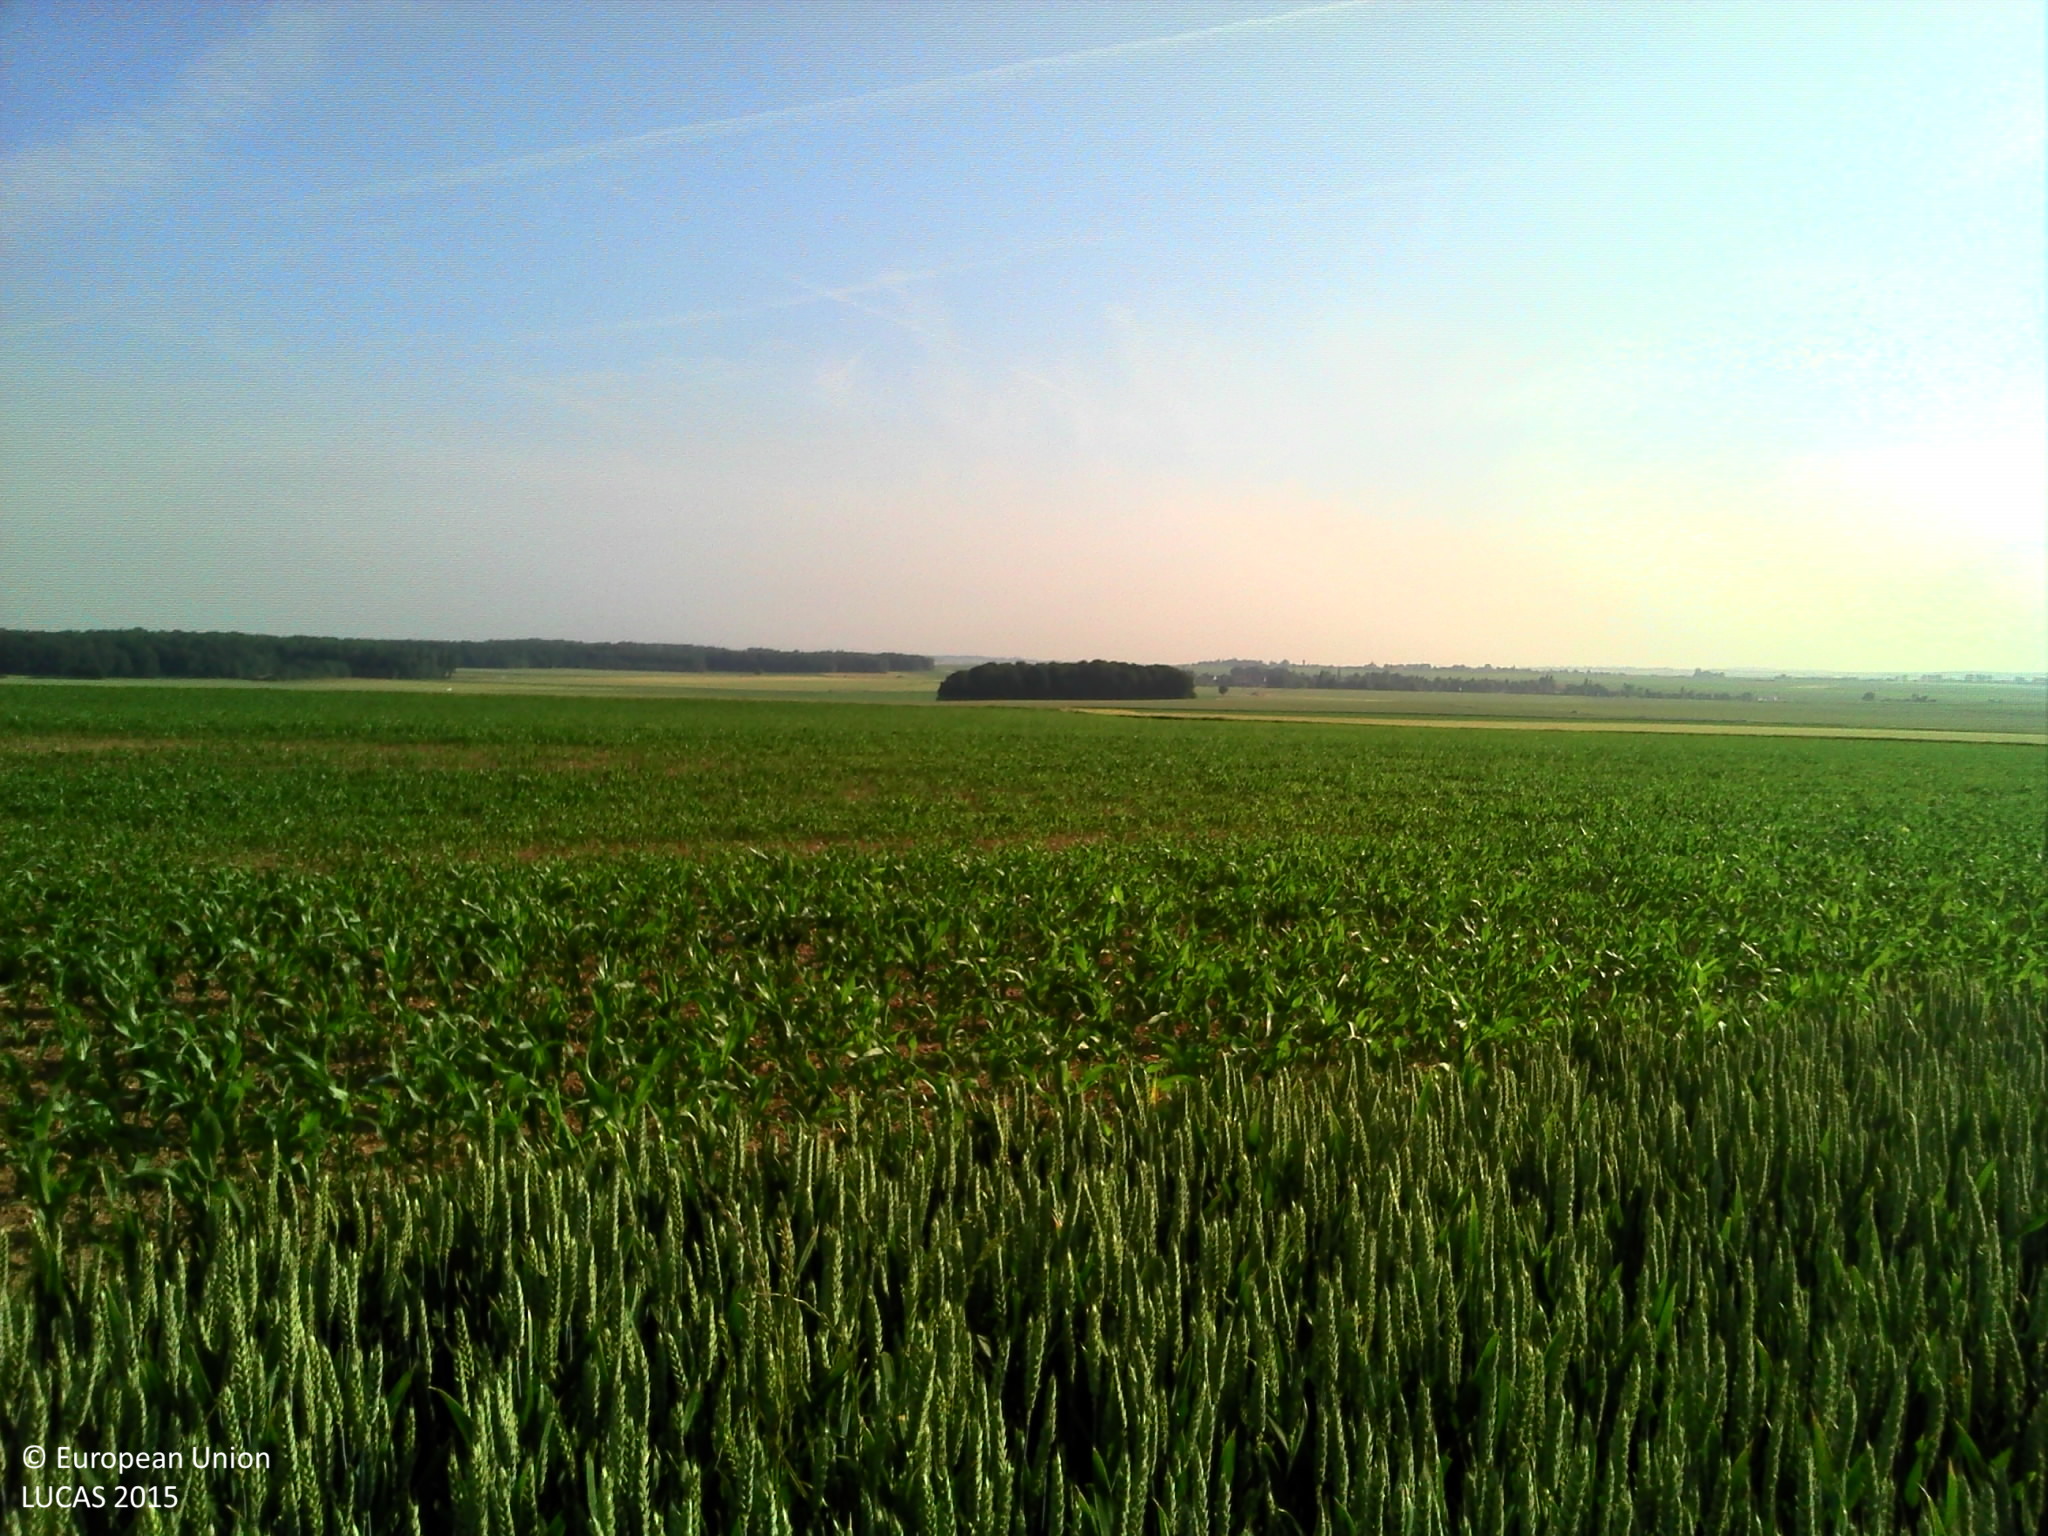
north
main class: Cropland
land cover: Common wheat
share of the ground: > 75 %
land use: Agriculture (excluding fallow land and kitchen gardens)
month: June
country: FR
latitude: 49.4350
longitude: 2.5557
